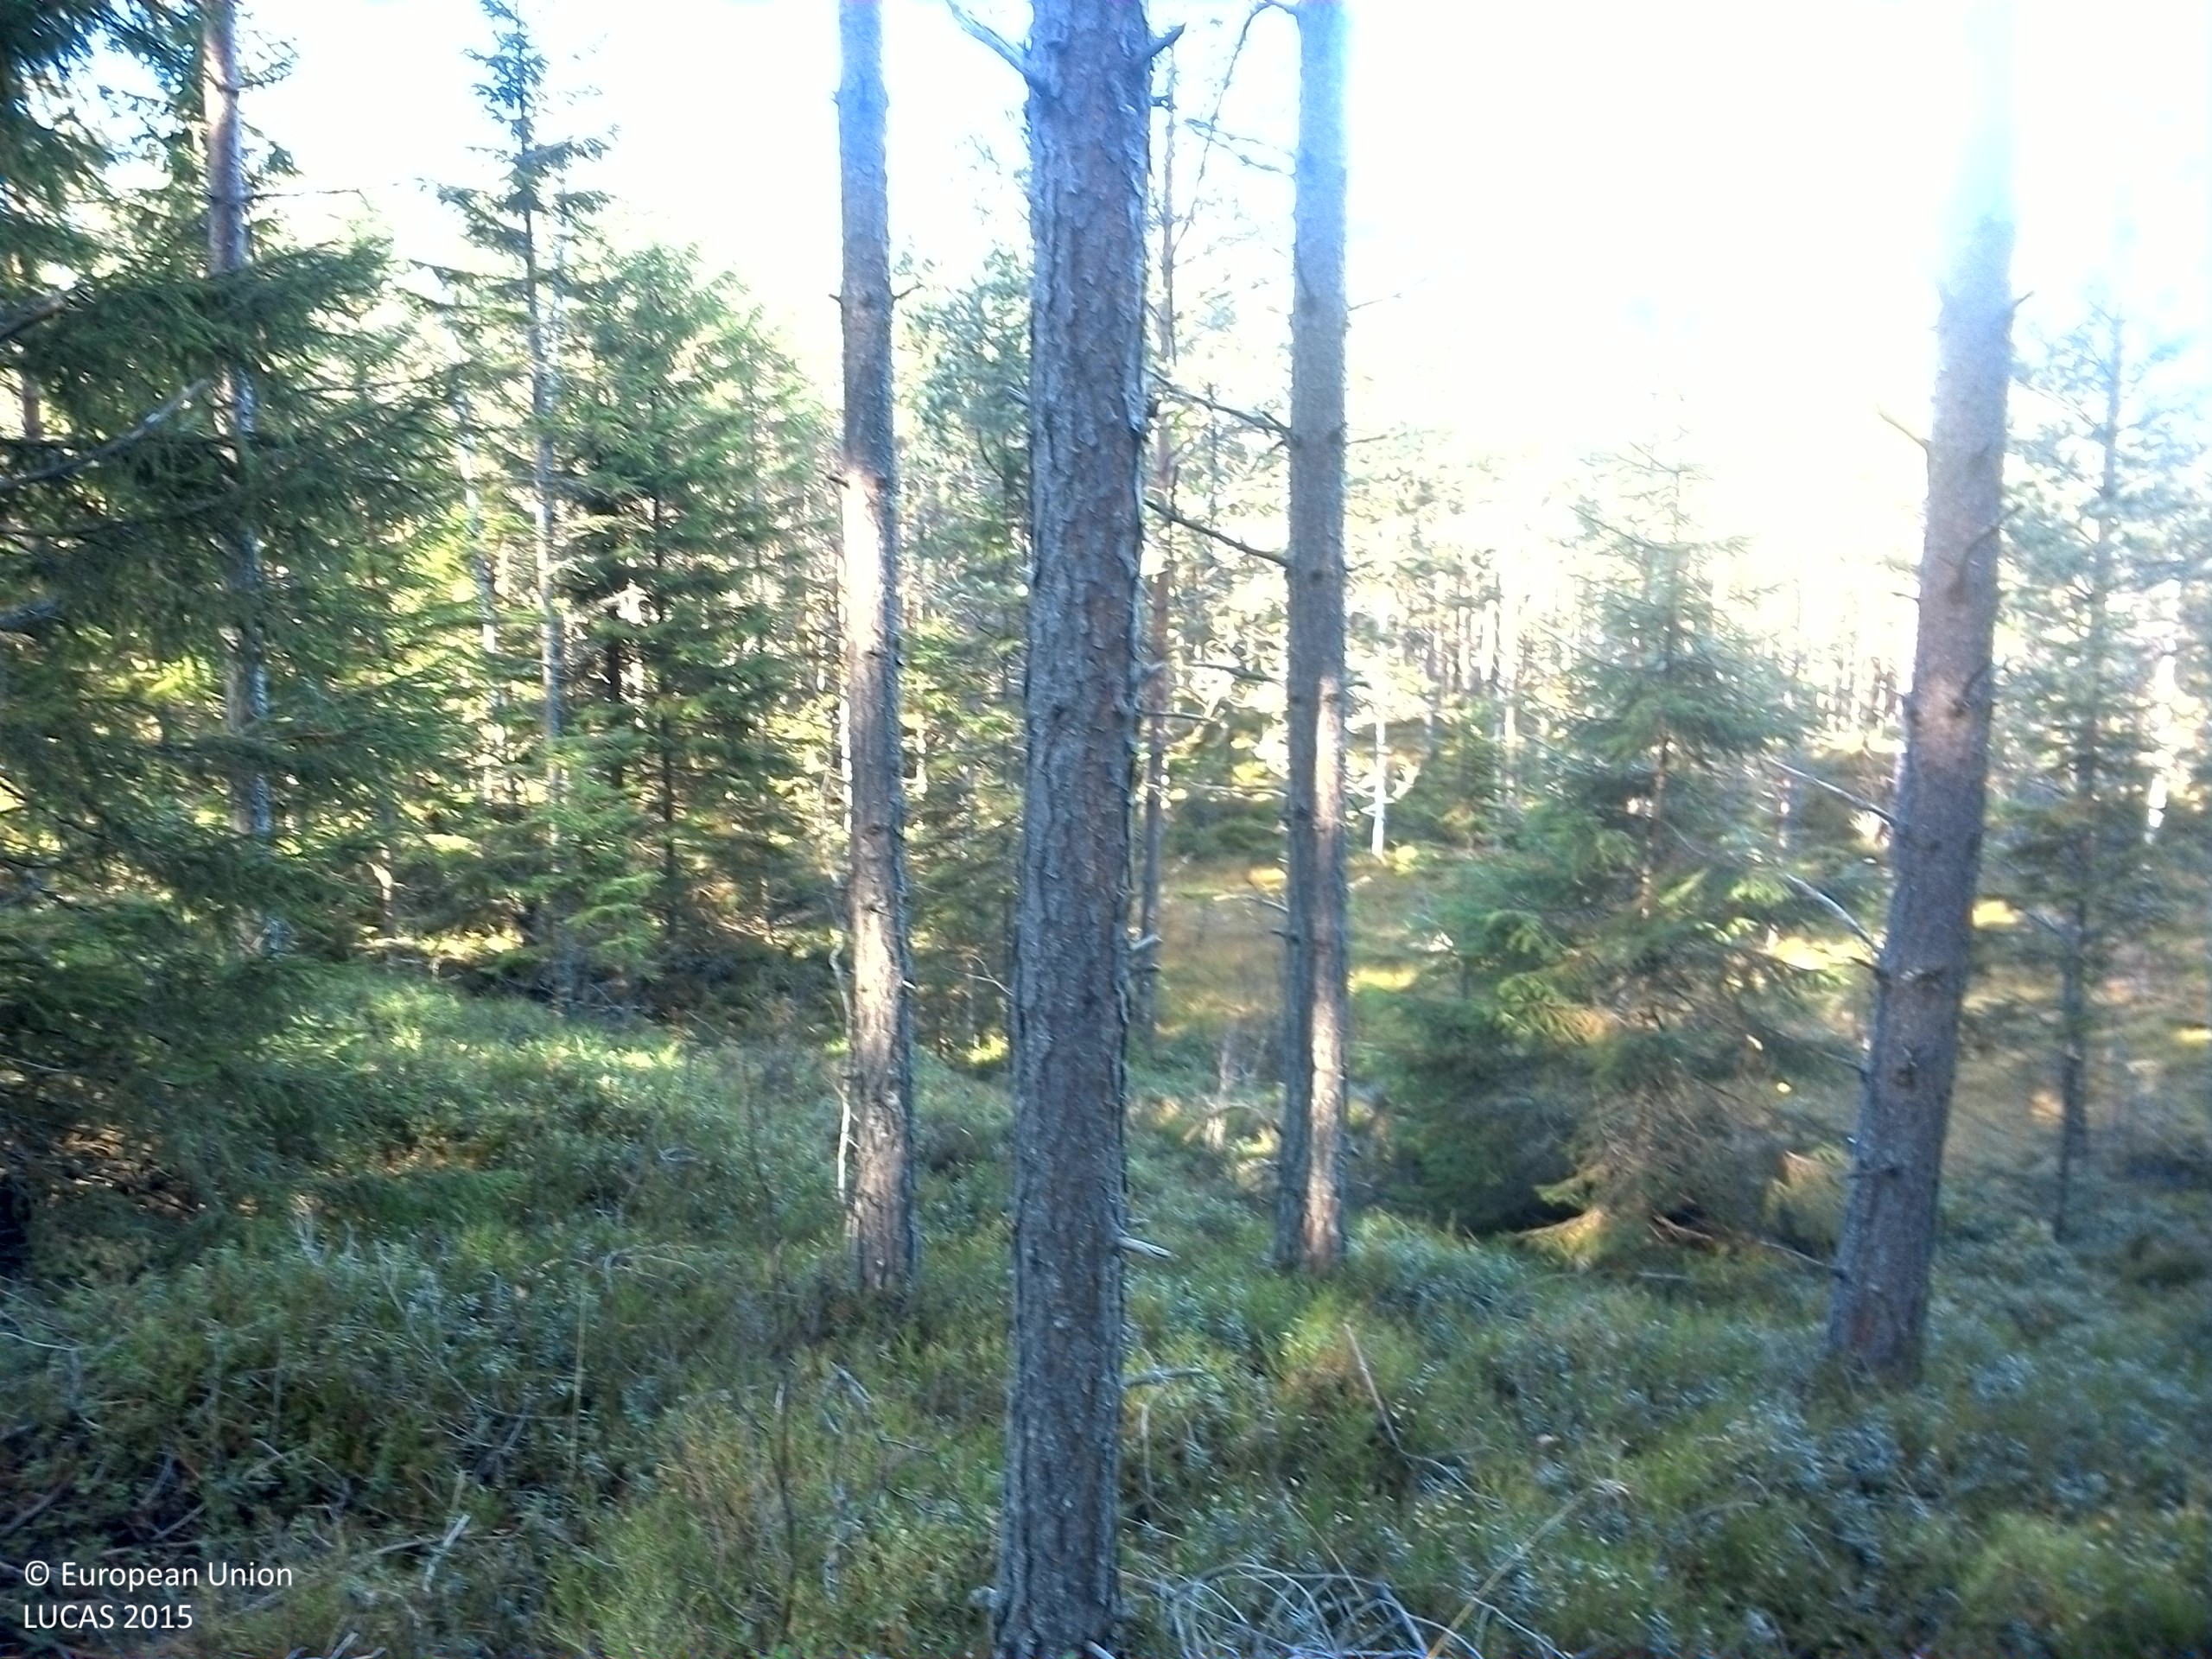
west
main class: Woodland
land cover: Pine dominated coniferous woodland
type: boreal forest
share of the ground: 50 - 75 %
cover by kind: coniferous forest trees 65 %, shrubs 20 %, lichens and mosses 10 %, herbaceous plants 5 %
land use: Forestry
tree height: > 5 m
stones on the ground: < 10 %
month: October
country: SE
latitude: 59.5764
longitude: 14.7886
